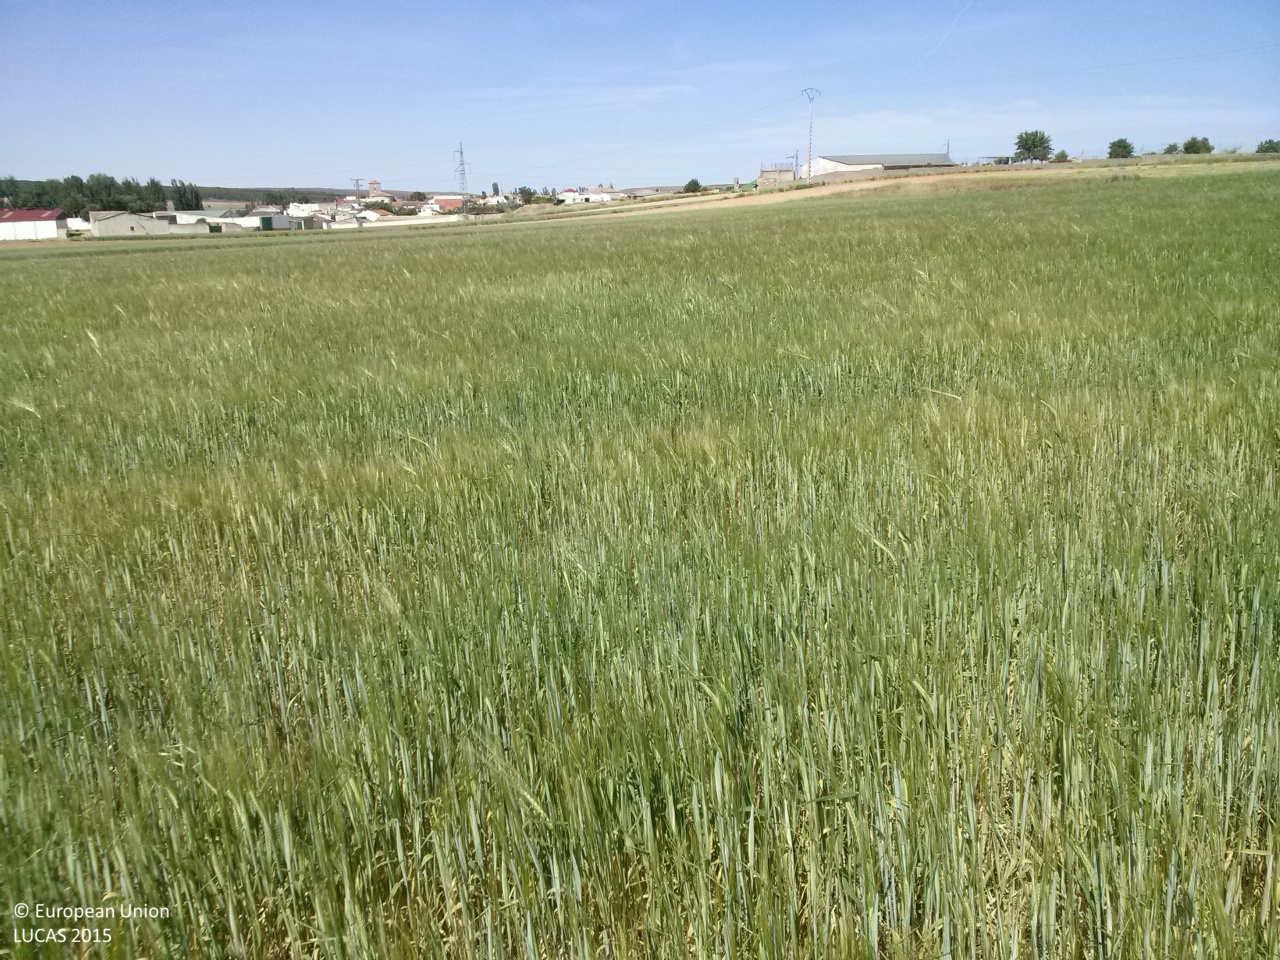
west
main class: Cropland
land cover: Barley
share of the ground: > 75 %
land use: Agriculture (excluding fallow land and kitchen gardens)
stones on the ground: < 10 %
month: May
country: ES
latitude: 39.9924
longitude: -2.7991
